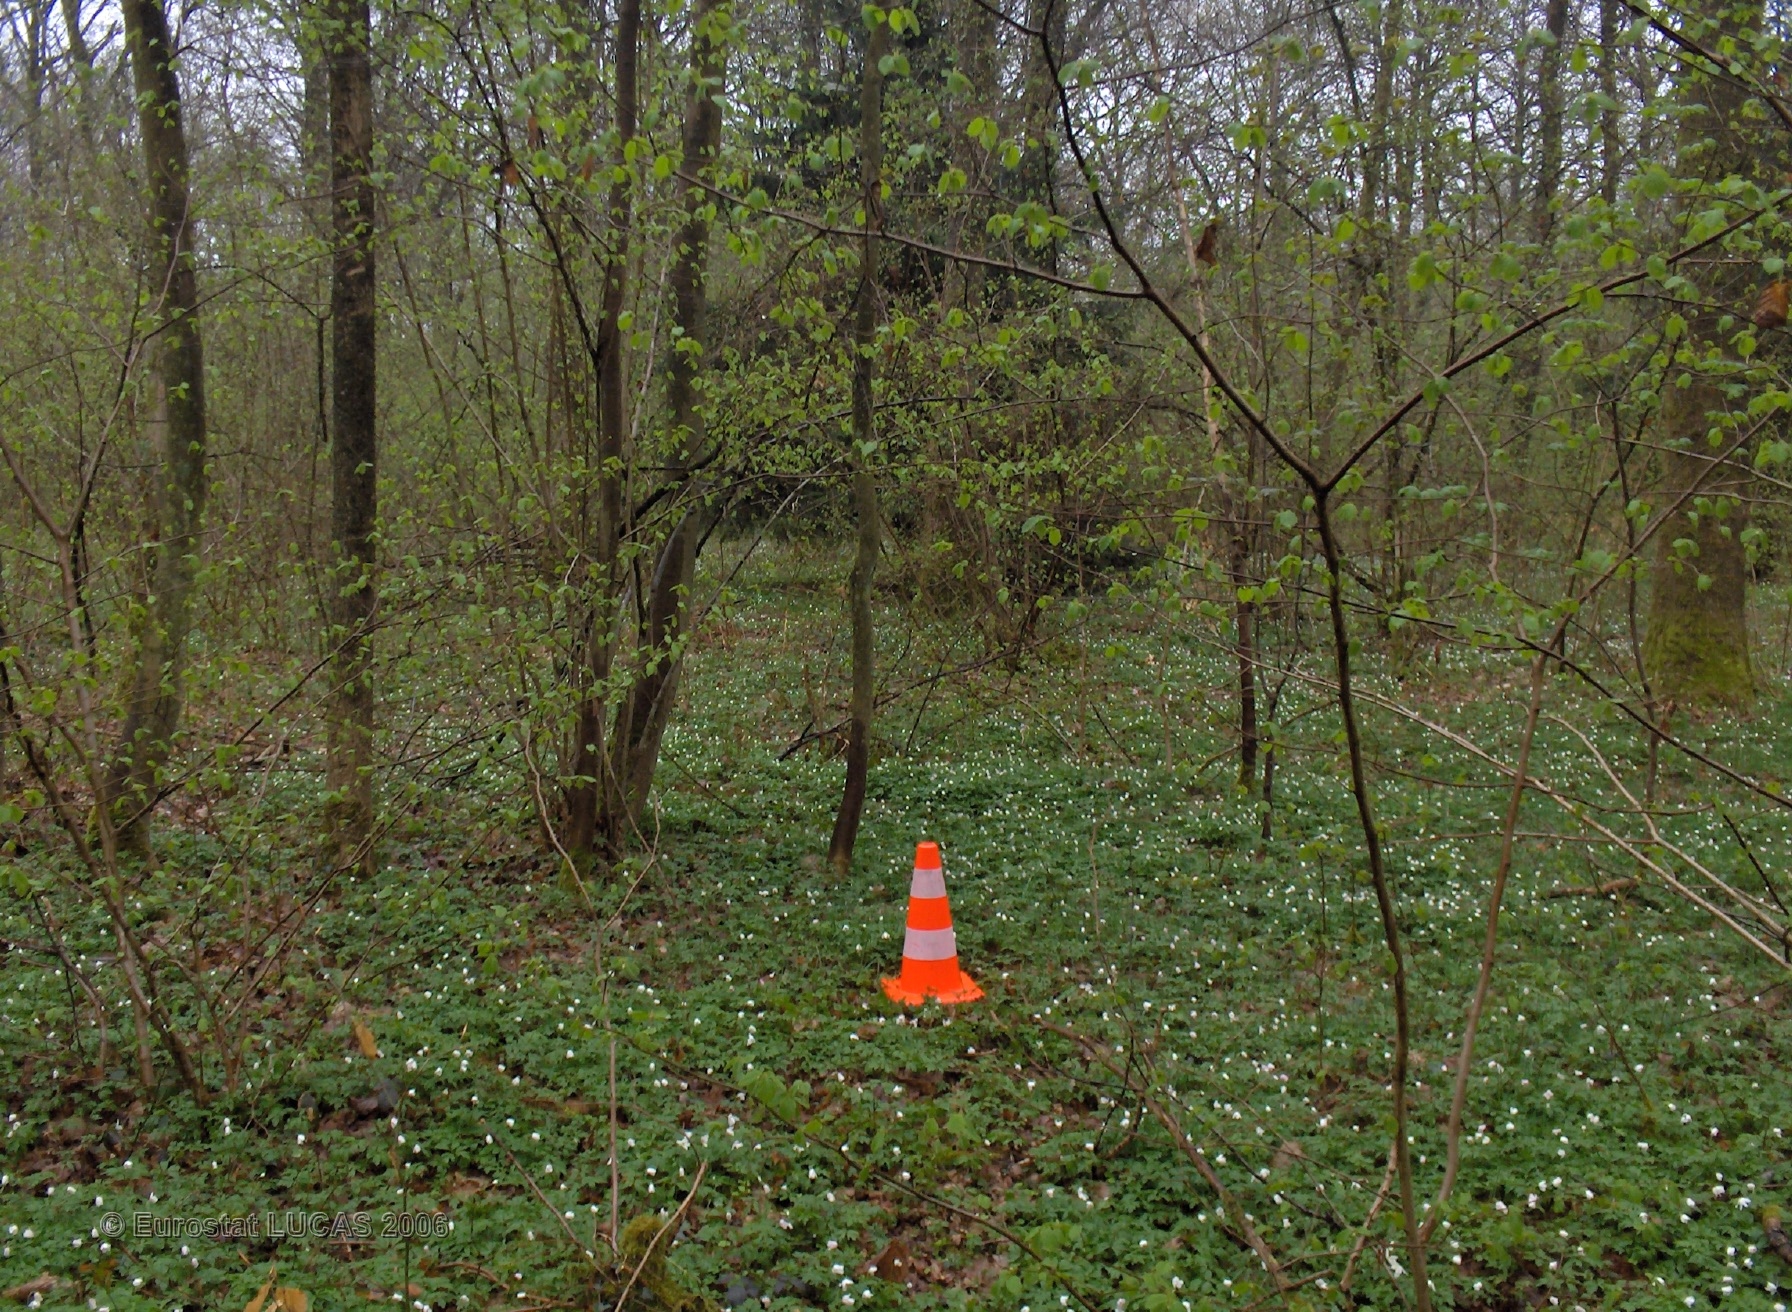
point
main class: Woodland
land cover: Broadleaved forest
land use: Forestry
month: April
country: BE
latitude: 50.2903
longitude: 4.5923
